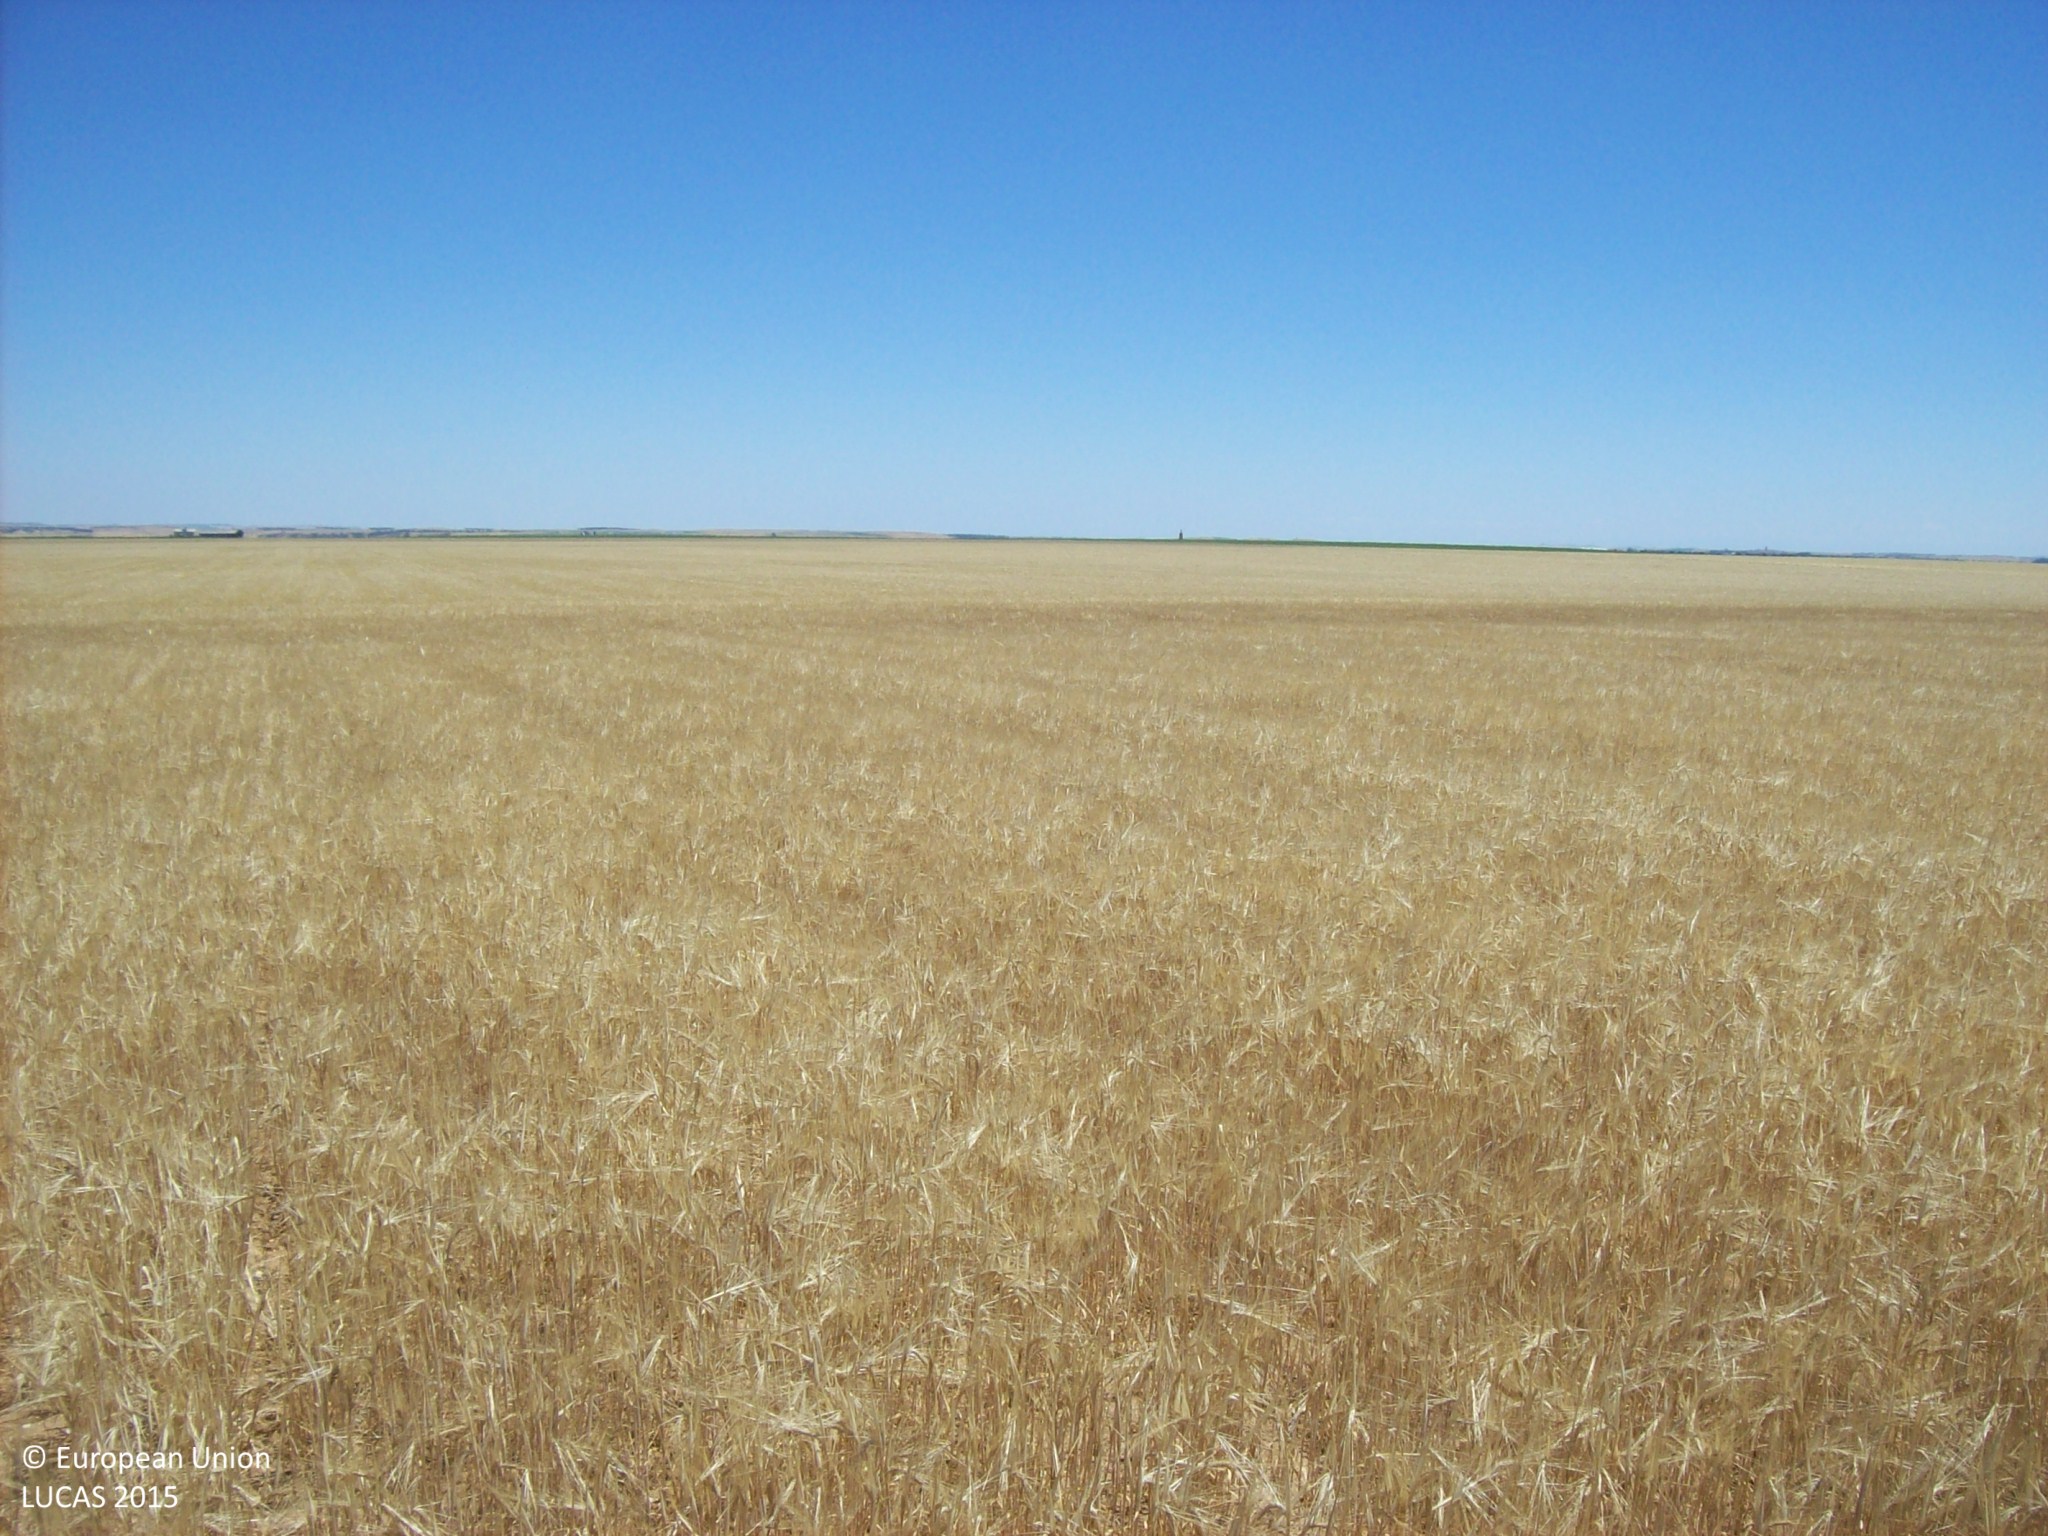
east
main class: Cropland
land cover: Barley
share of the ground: > 75 %
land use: Agriculture (excluding fallow land and kitchen gardens)
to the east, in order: Barley; Grass margins; Tracks; Grass margins; Barley
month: June
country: ES
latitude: 41.2364
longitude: -5.2375
